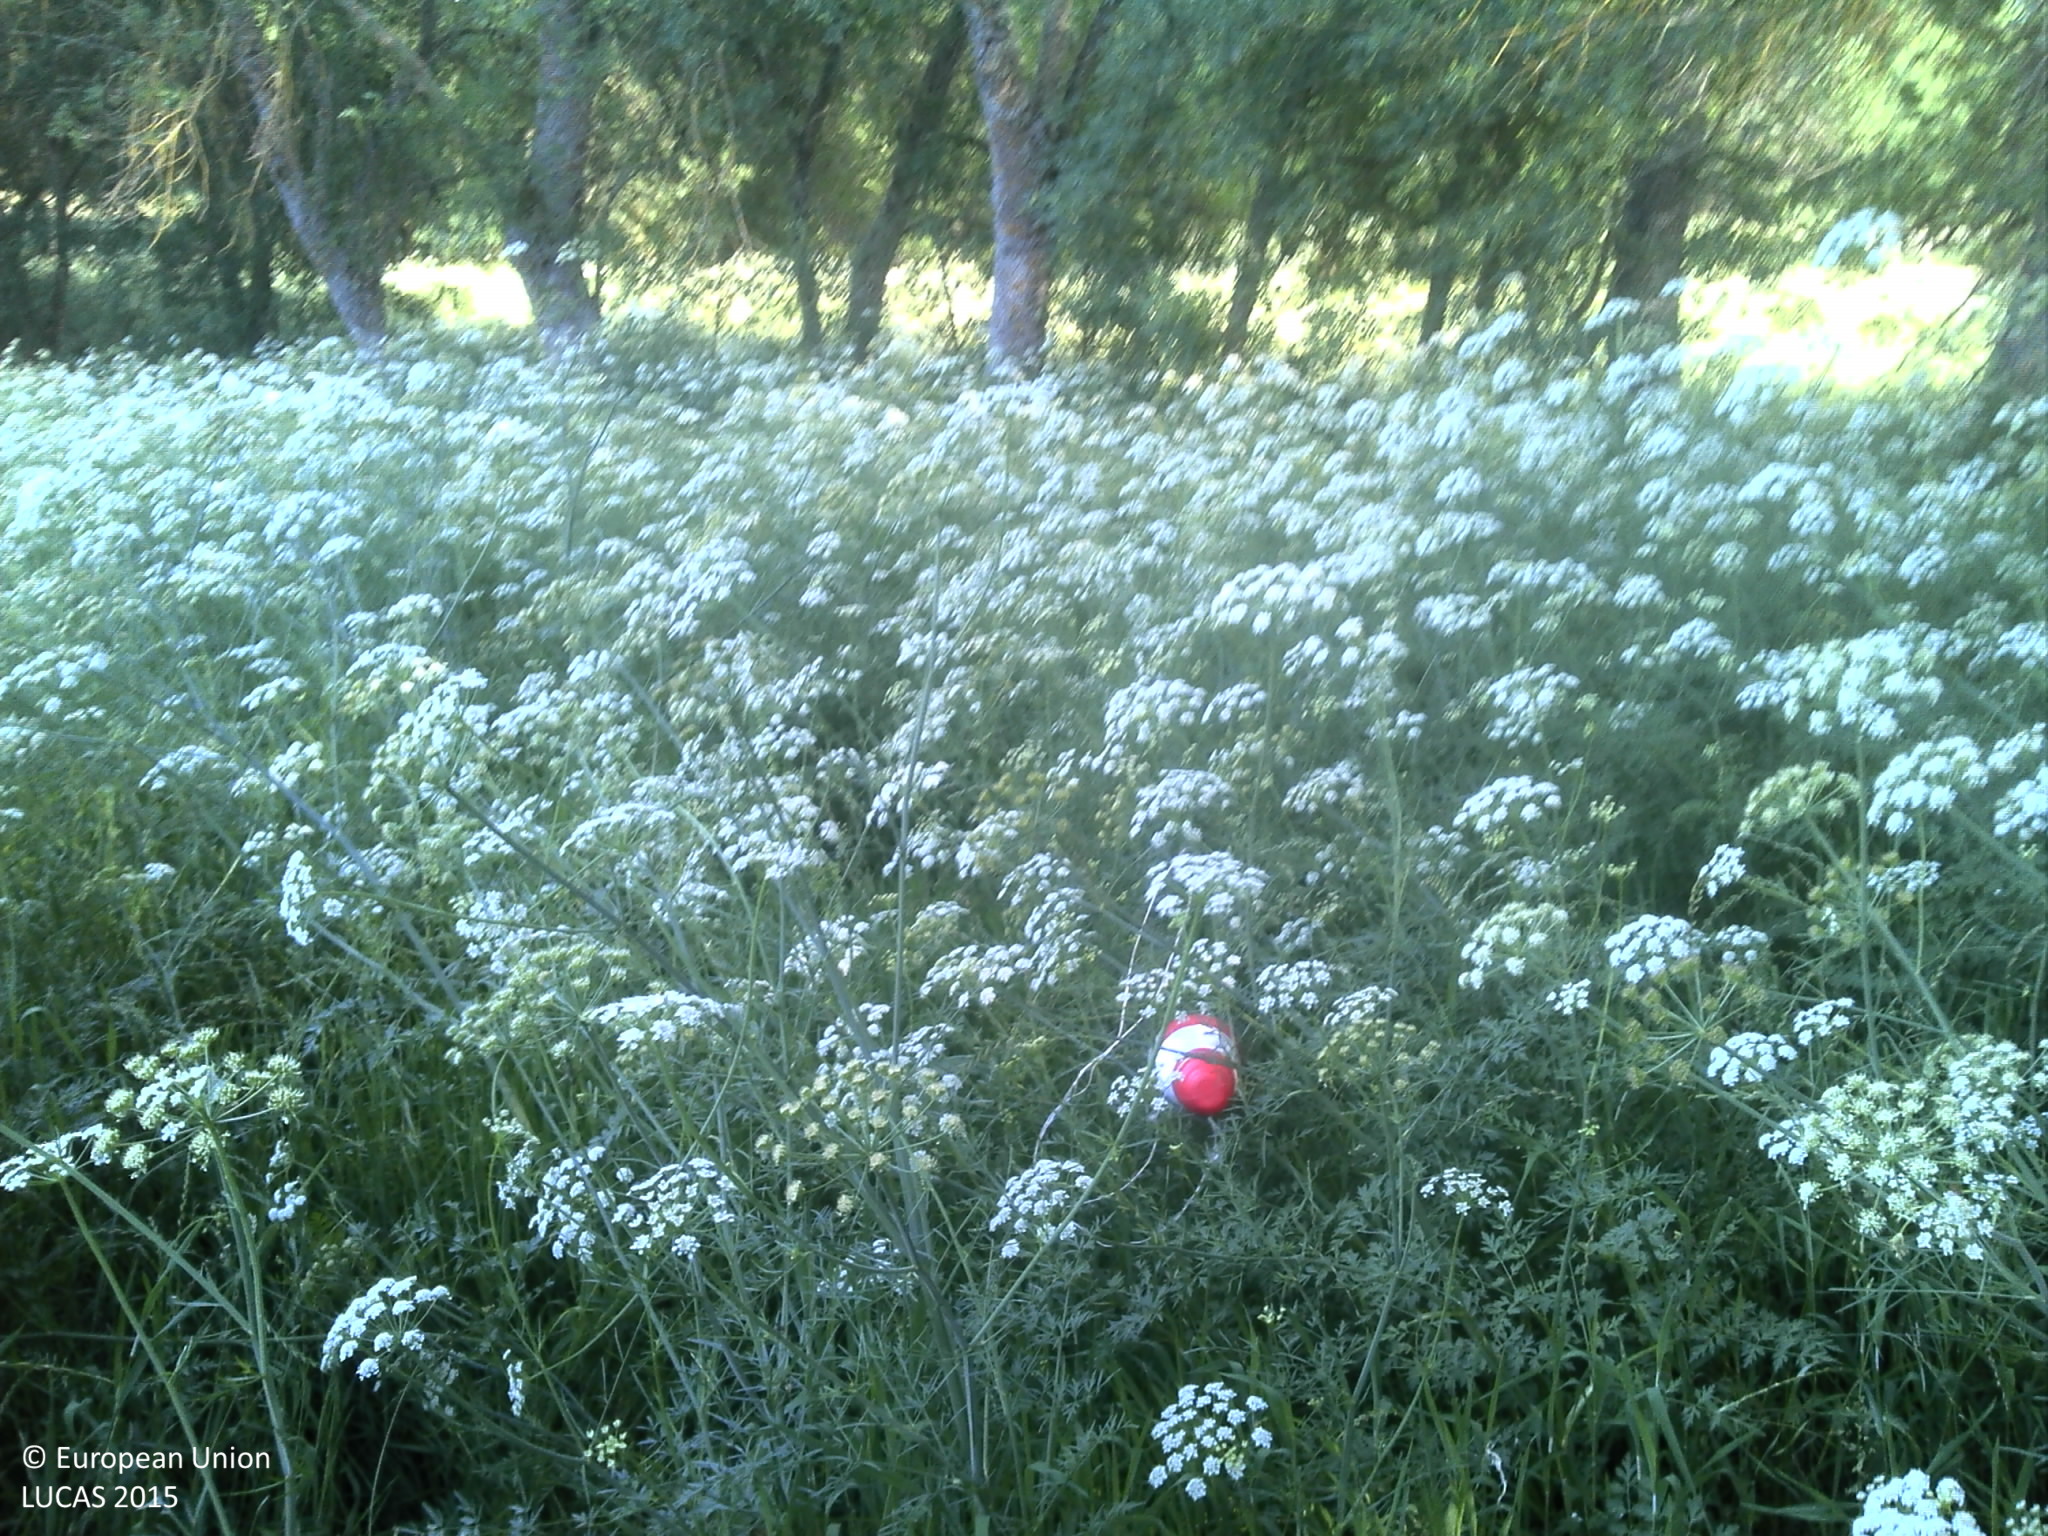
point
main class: Grassland
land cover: Spontaneously vegetated surfaces
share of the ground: 50 - 75 %
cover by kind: herbaceous plants 80 %, unconsolidated bare surface 20 %
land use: Fallow land
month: June
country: PT
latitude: 40.4650
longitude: -7.1193
